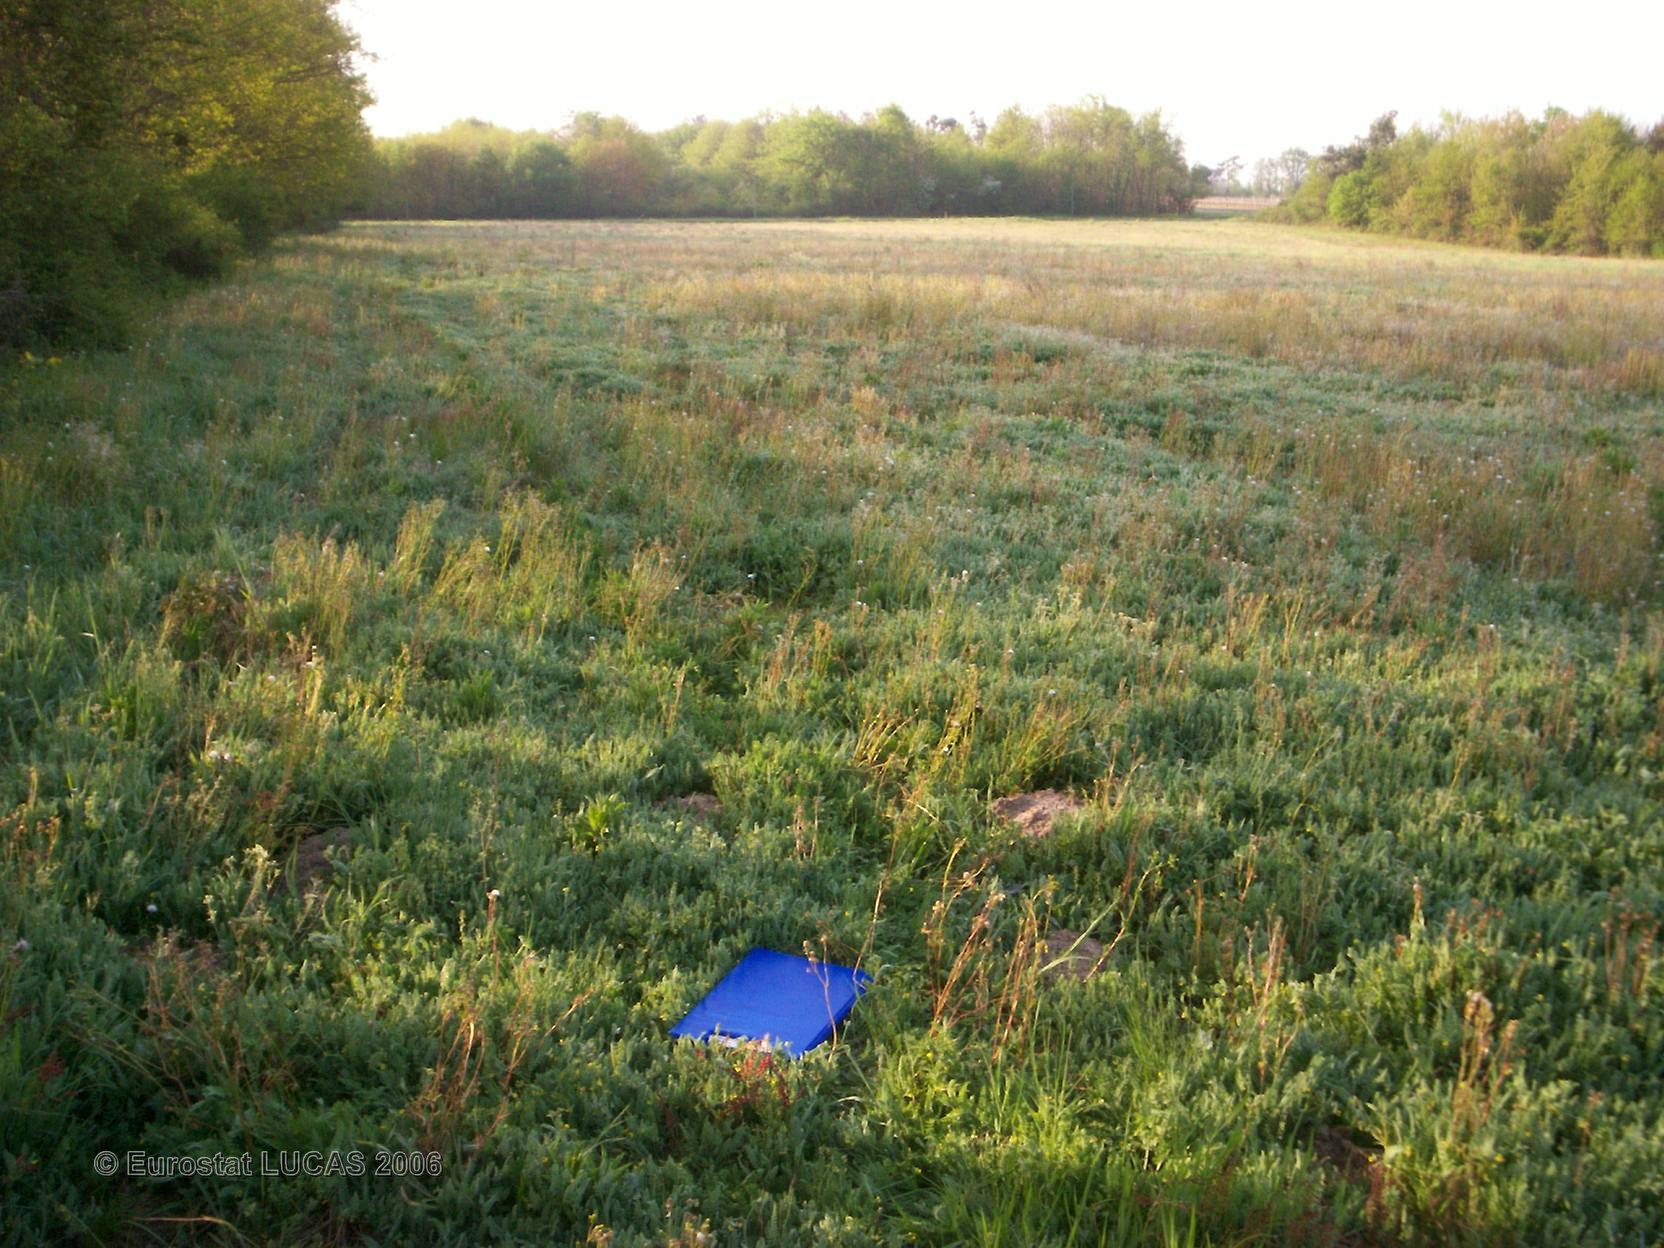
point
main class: Grassland
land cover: Grassland without tree/shrub cover
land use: Agriculture (excluding fallow land and kitchen gardens)
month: May
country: FR
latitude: 45.5183
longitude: -0.7391
